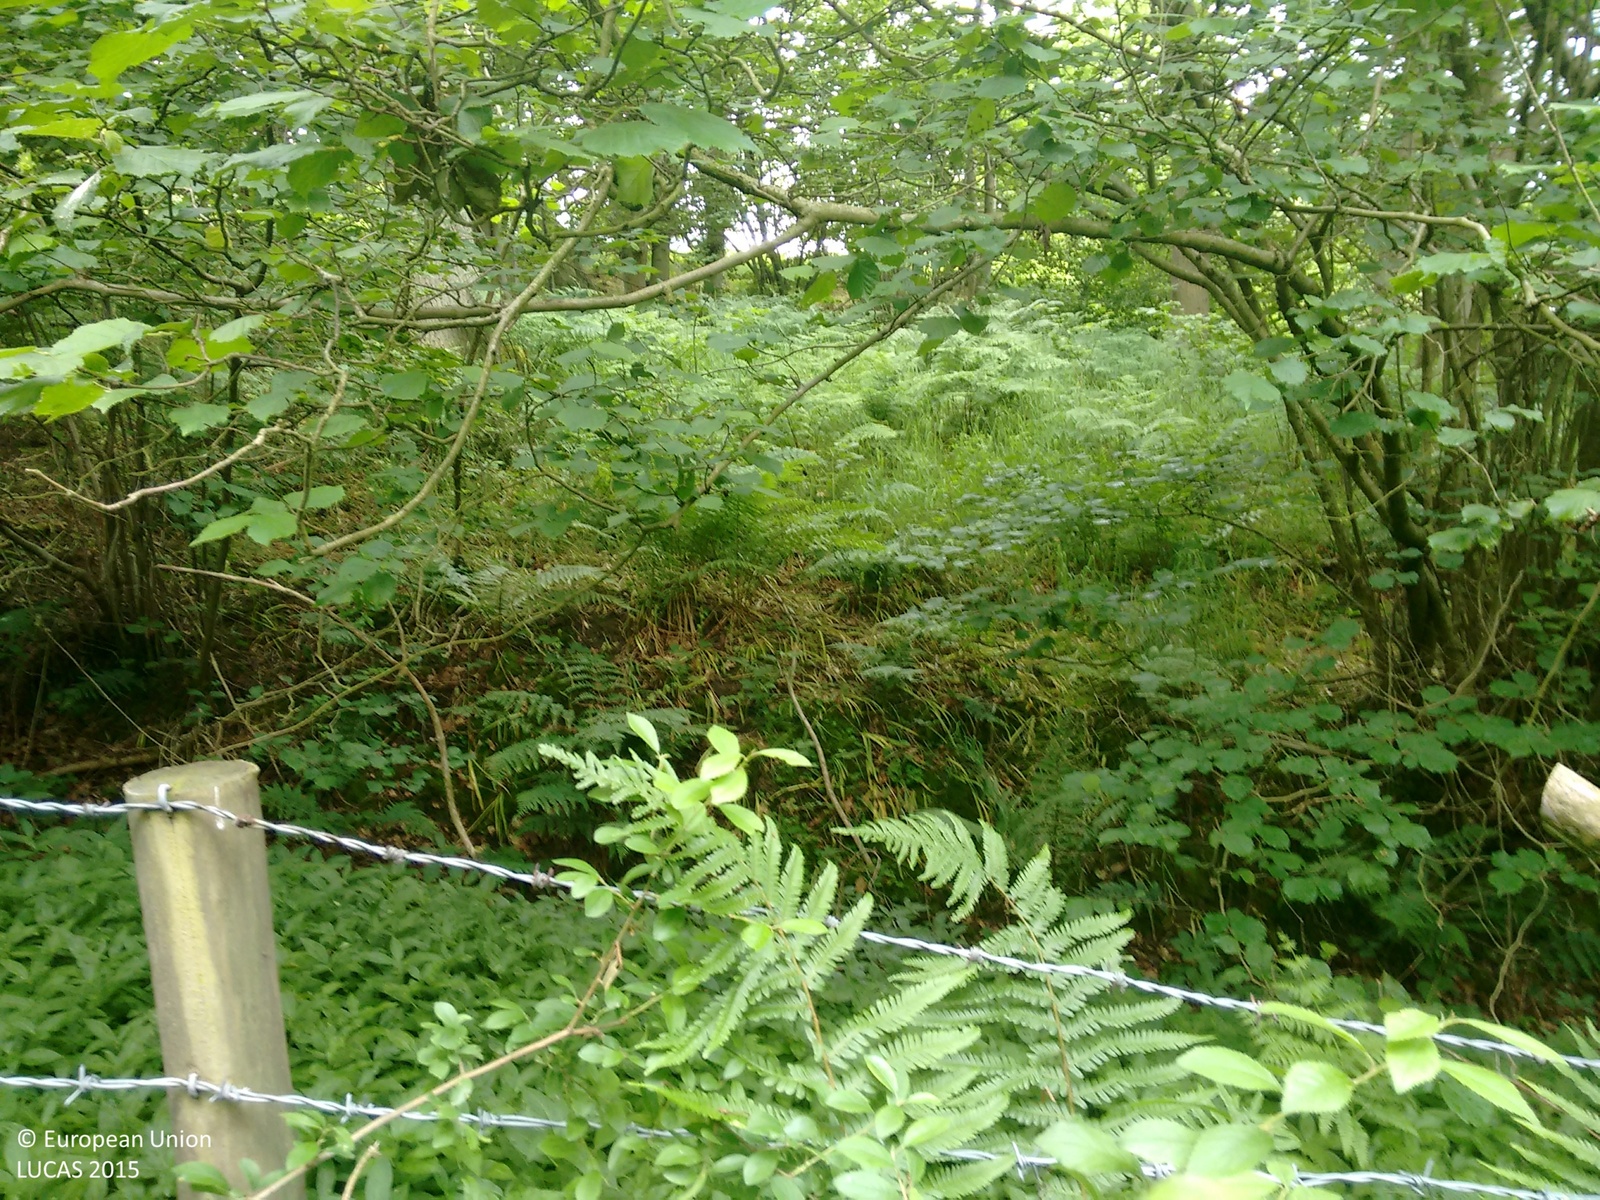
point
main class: Woodland
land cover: Broadleaved woodland
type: mesophytic deciduous forest
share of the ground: > 75 %
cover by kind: broadleaved forest trees 80 %, coniferous forest trees 20 %
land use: Forestry
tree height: > 5 m
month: June
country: GB
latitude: 54.4307
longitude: -1.1271
